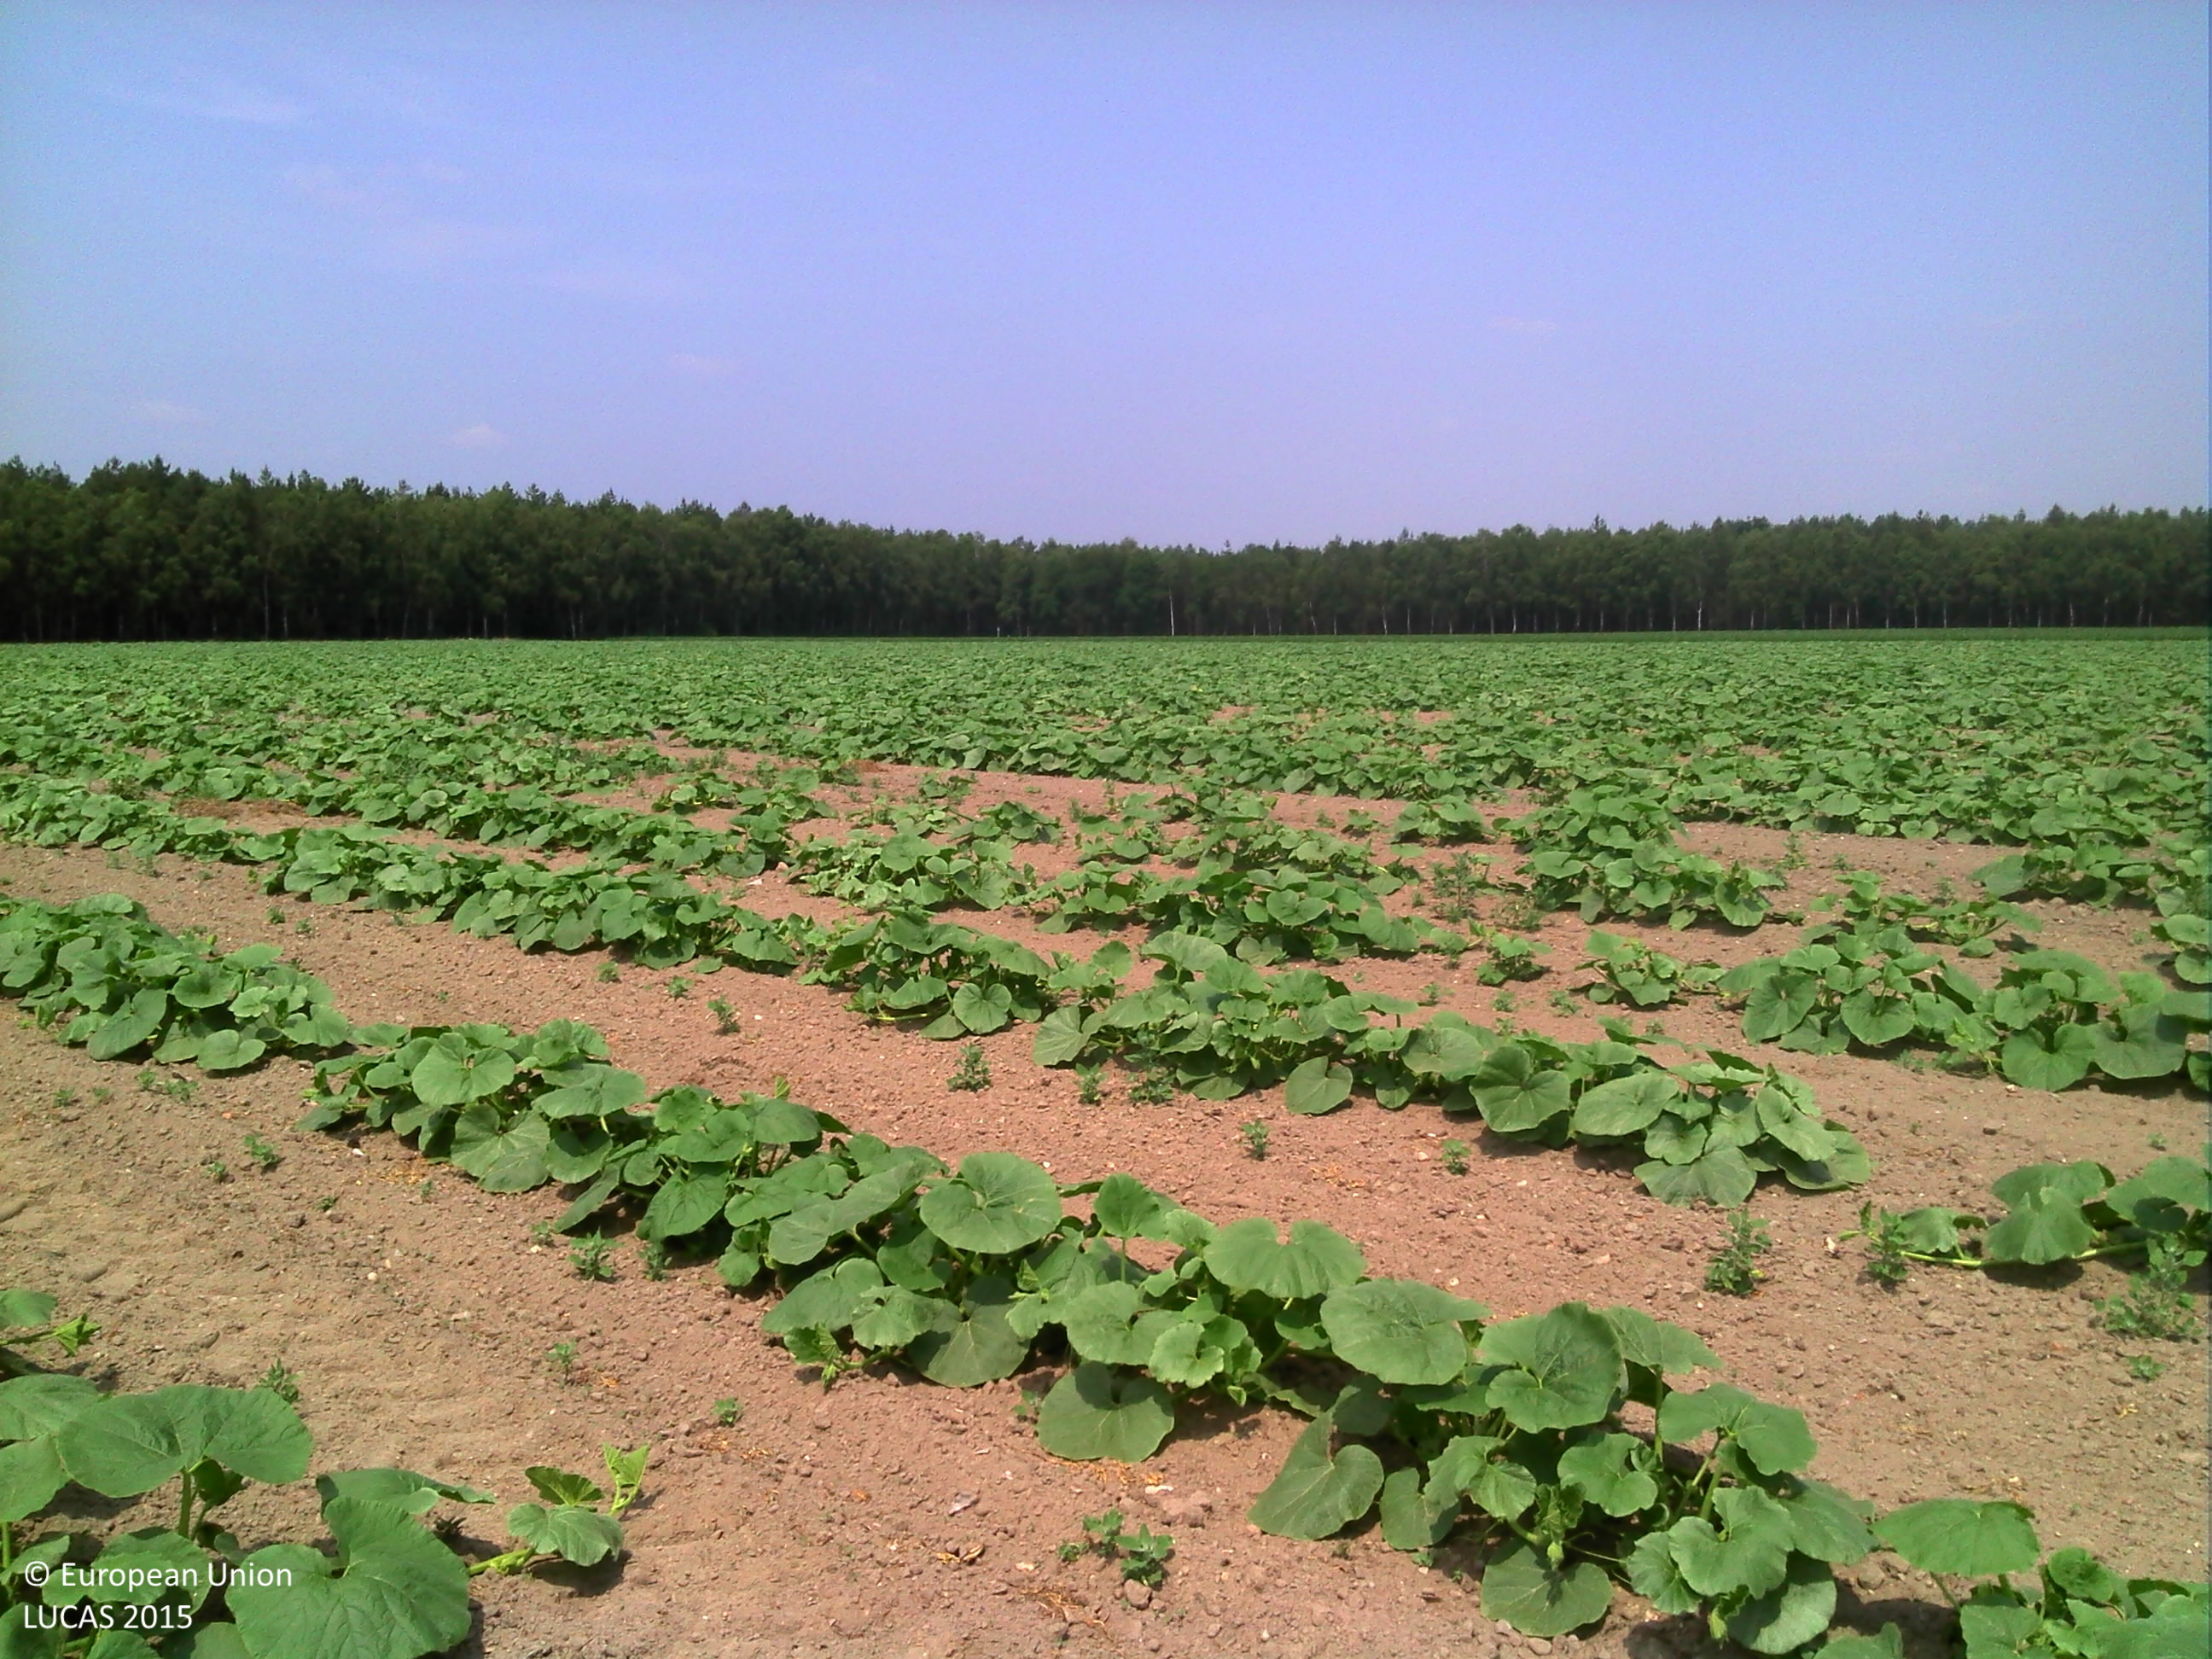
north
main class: Cropland
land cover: Other fresh vegetables
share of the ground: 10 - 25 %
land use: Agriculture (excluding fallow land and kitchen gardens)
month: July
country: BE
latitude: 51.0512
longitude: 5.5331
